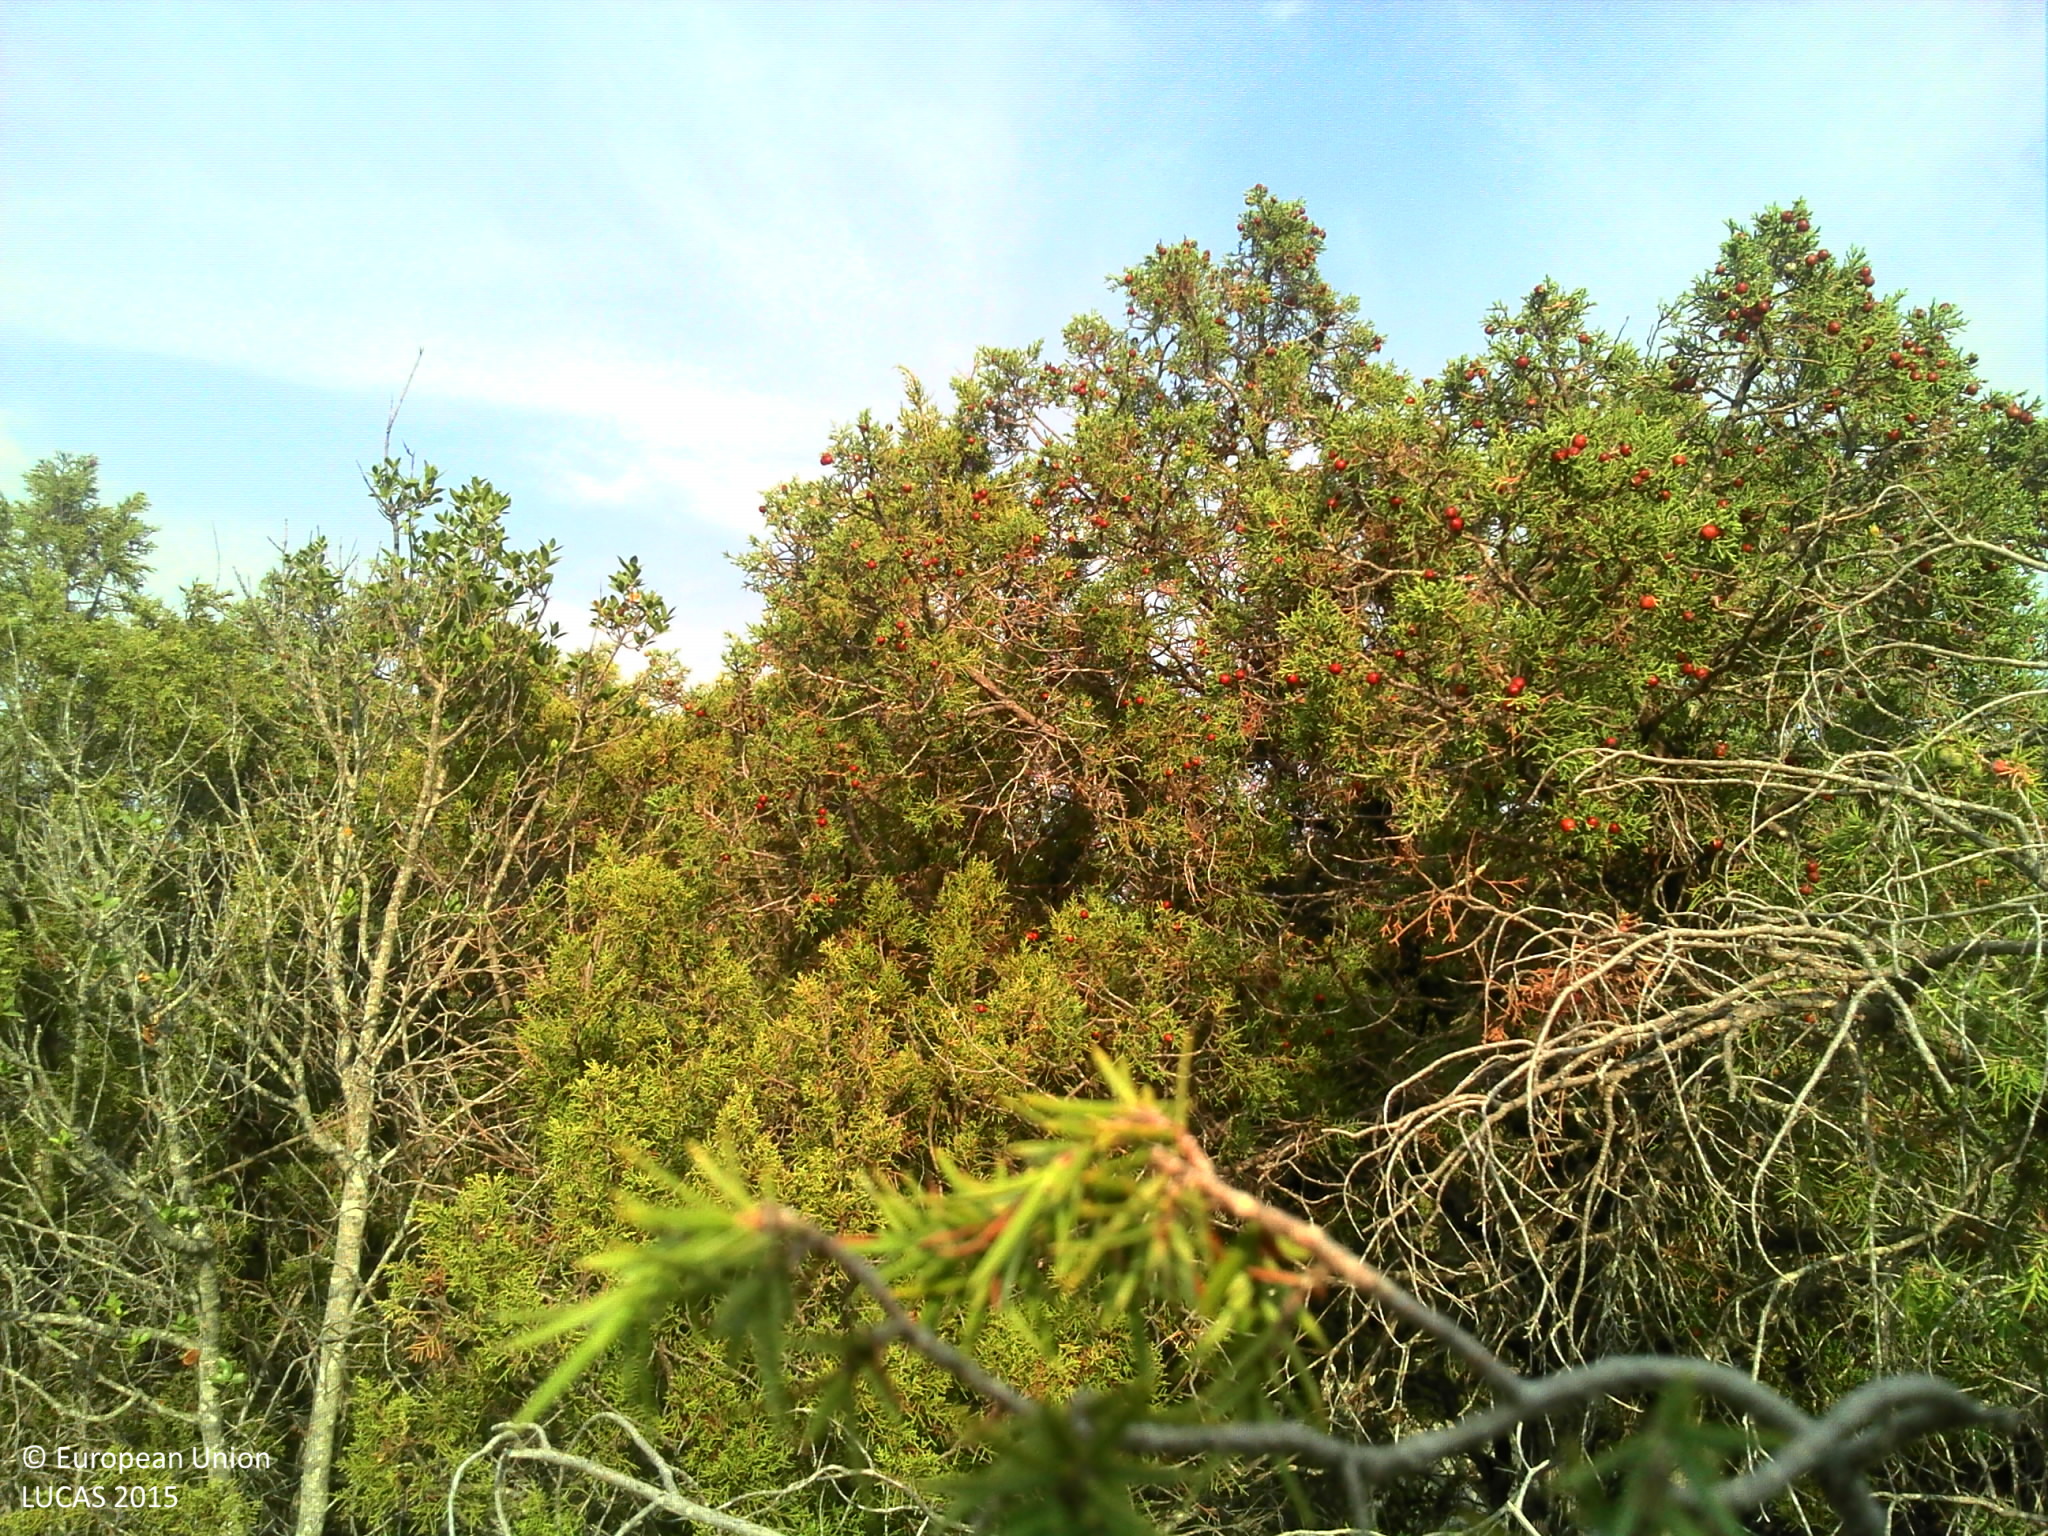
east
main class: Shrubland
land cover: Shrubland without tree cover
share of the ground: > 75 %
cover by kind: shrubs 70 %, unconsolidated bare surface 30 %
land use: Semi-natural and natural areas not in use
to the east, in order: Shrubland without tree cover; Dry stone walls; Shrubland without tree cover; Rocks and stones; Paved roads, cycling and walking lanes; Grassland without tree/shrub cover; Electric lines; Shrubland with sparse tree cover; Rivers and streams; Broadleaved woodland; Spruce dominated mixed woodland
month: August
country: FR
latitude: 43.6012
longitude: 6.3787
